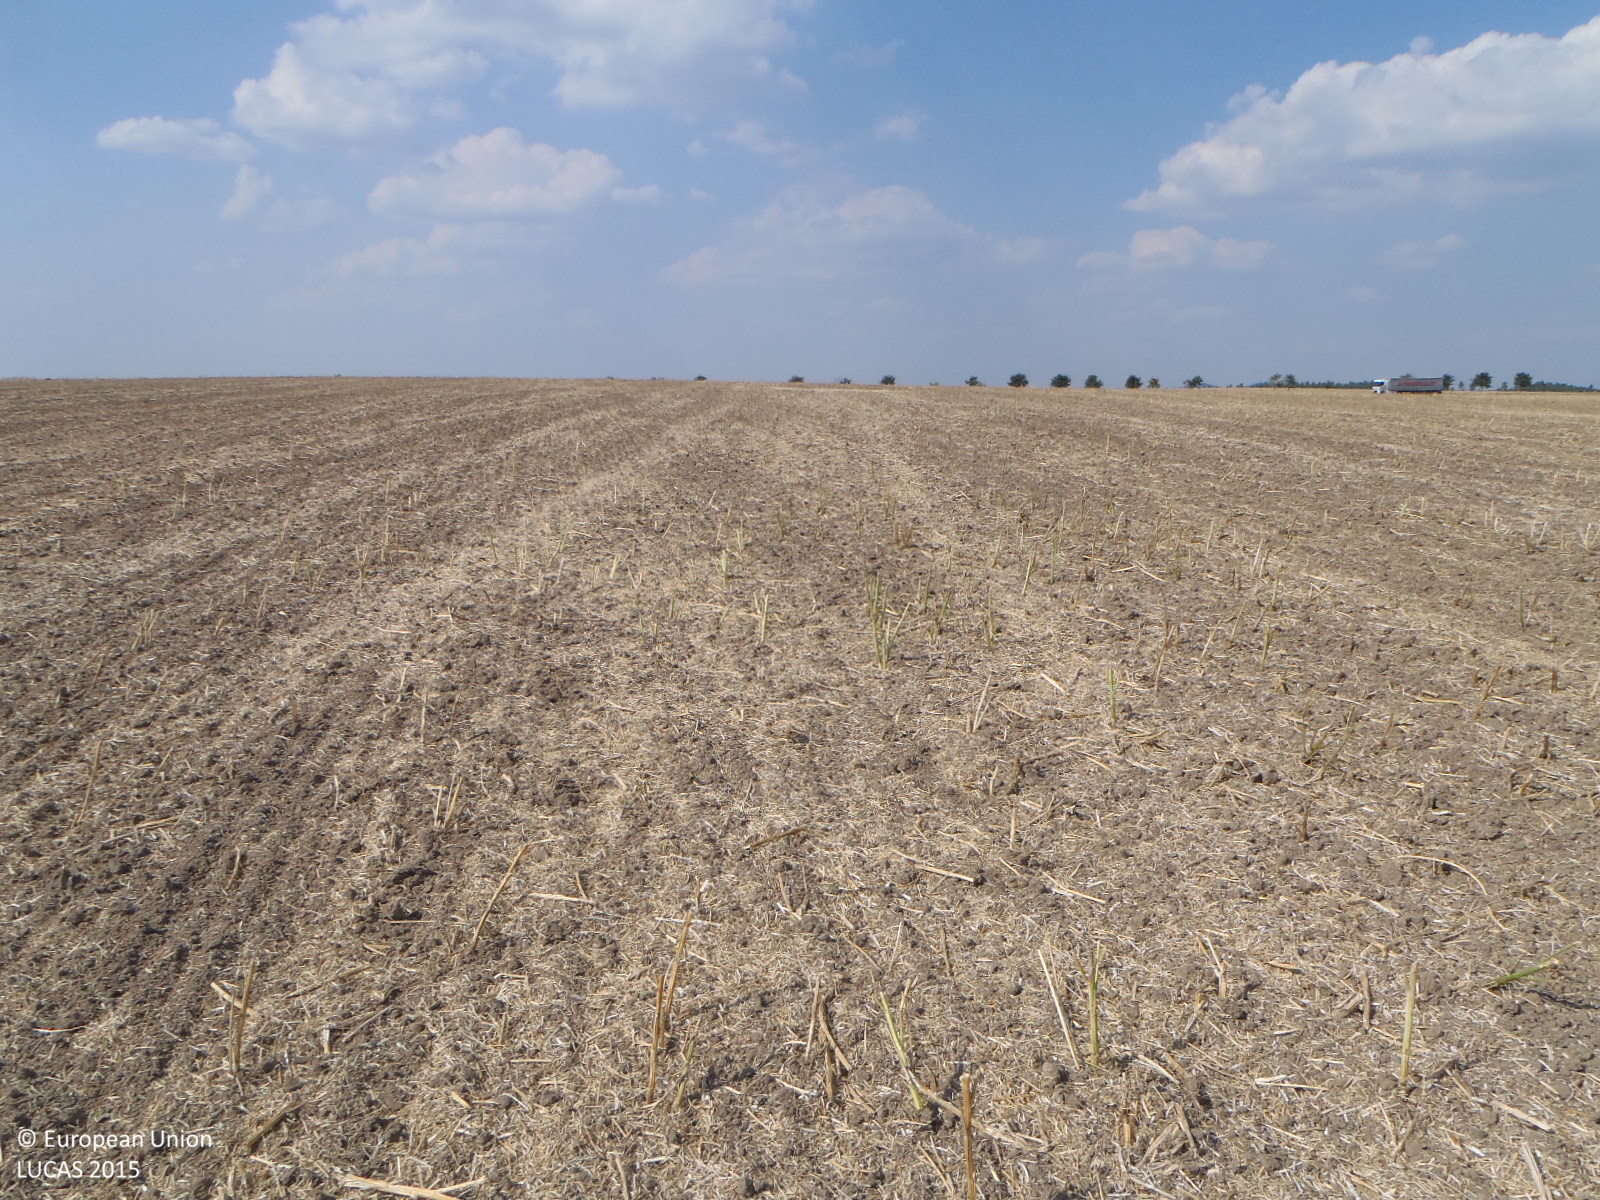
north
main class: Cropland
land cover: Rape and turnip rape
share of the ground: 50 - 75 %
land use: Agriculture (excluding fallow land and kitchen gardens)
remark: Harvested field
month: August
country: CZ
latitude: 50.6341
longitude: 14.5404
